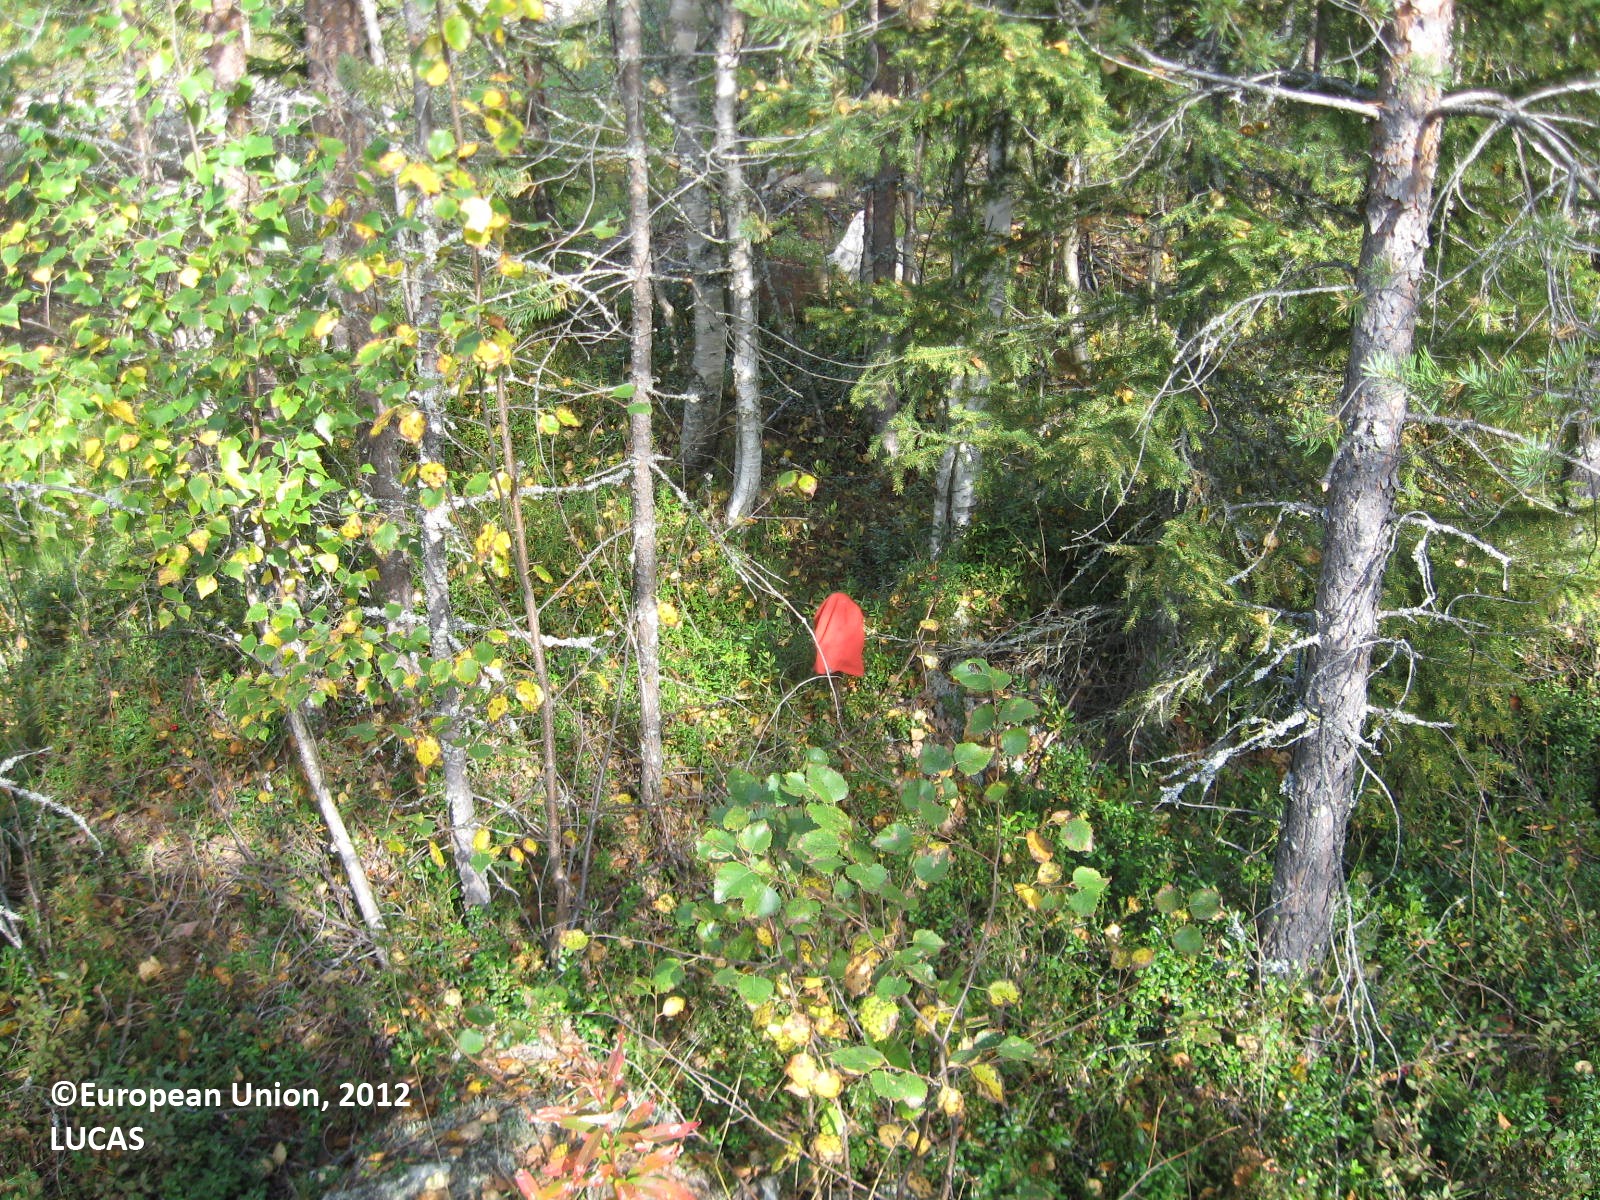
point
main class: Woodland
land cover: Pine dominated mixed woodland
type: boreal forest
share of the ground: > 75 %
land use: Forestry
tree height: > 5 m
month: August
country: FI
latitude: 63.9251
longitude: 28.6854
